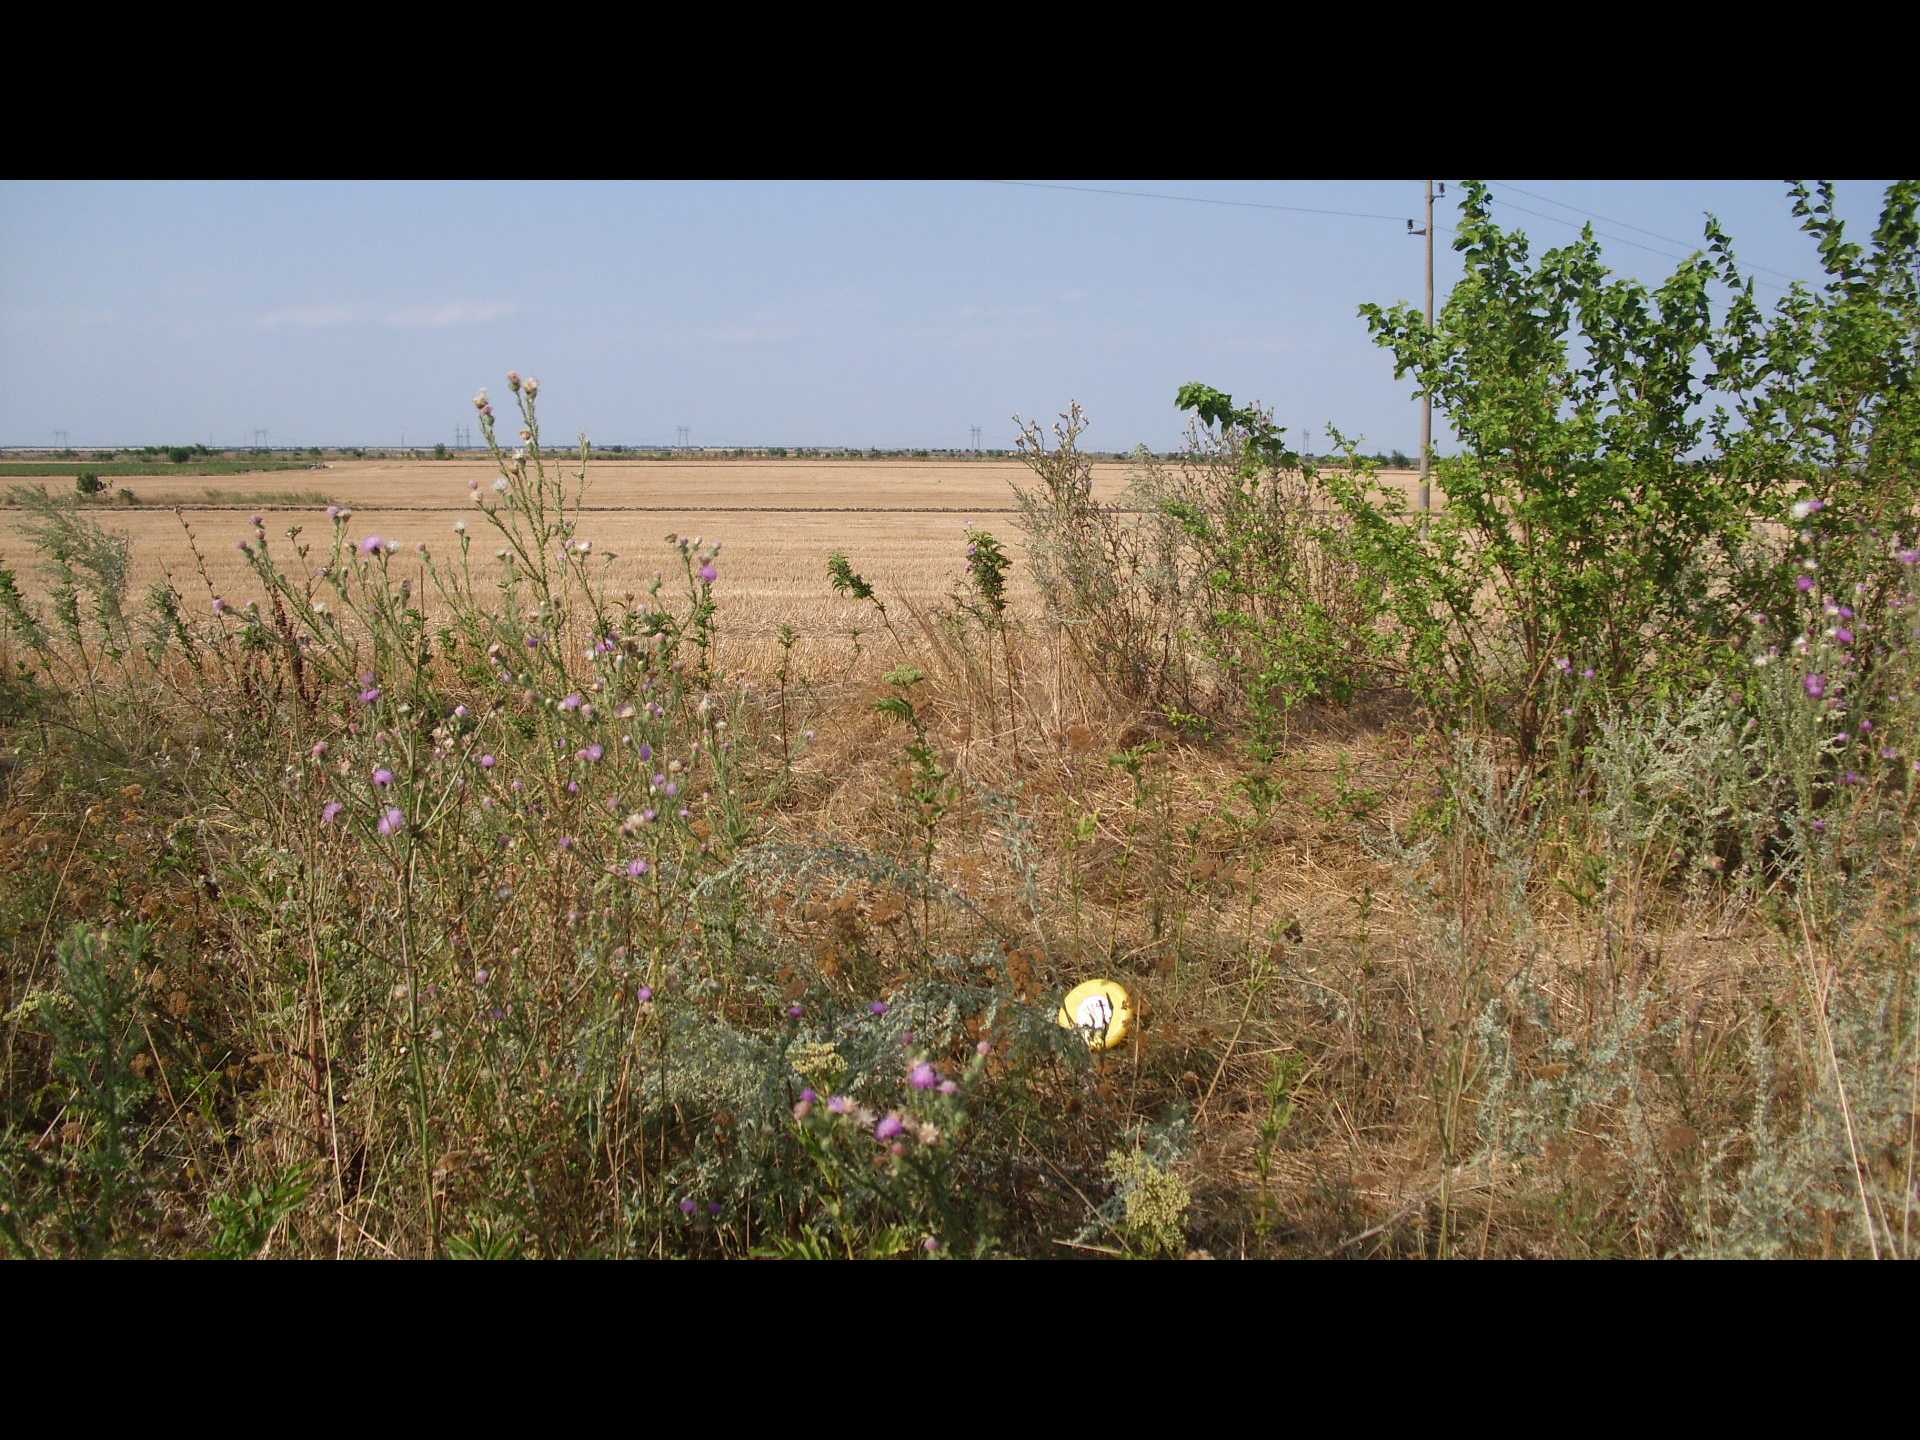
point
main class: Grassland
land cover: Grassland with sparse tree/shrub cover
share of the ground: > 75 %
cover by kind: herbaceous plants 85 %, shrubs 10 %, broadleaved forest trees 5 %
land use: Agriculture (excluding fallow land and kitchen gardens)
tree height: < 5 m
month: August
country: BG
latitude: 43.6672
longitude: 23.7542
